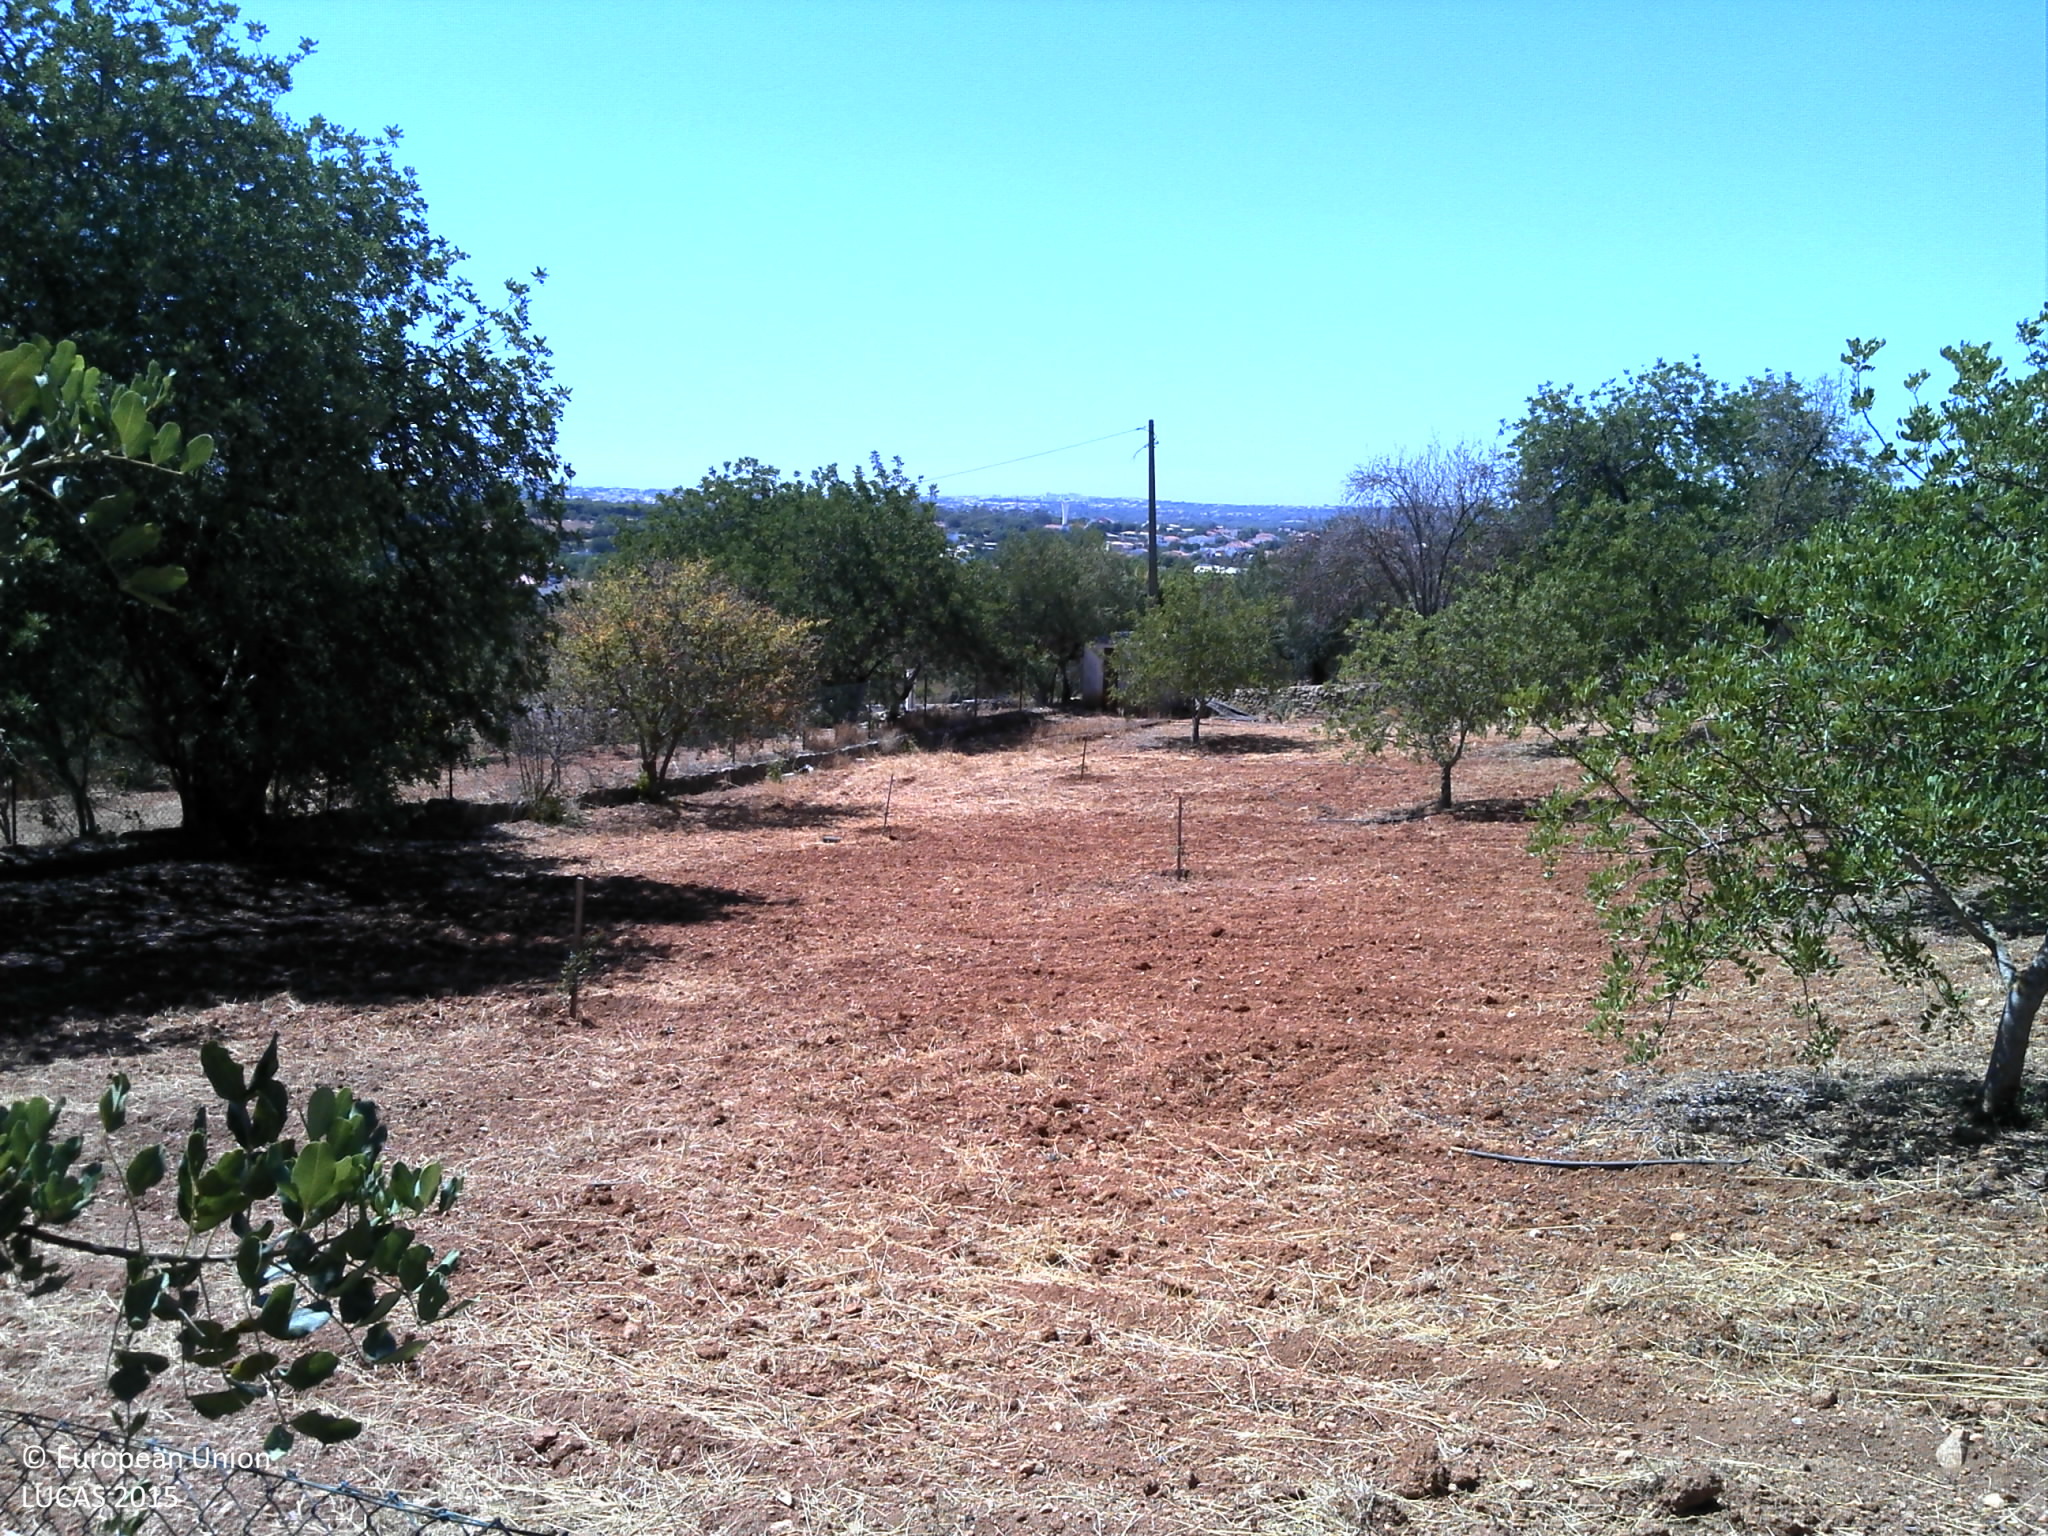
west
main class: Cropland
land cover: Permanent industrial crops
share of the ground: 25 - 50 %
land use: Agriculture (excluding fallow land and kitchen gardens)
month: September
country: PT
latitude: 37.1201
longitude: -8.1241
